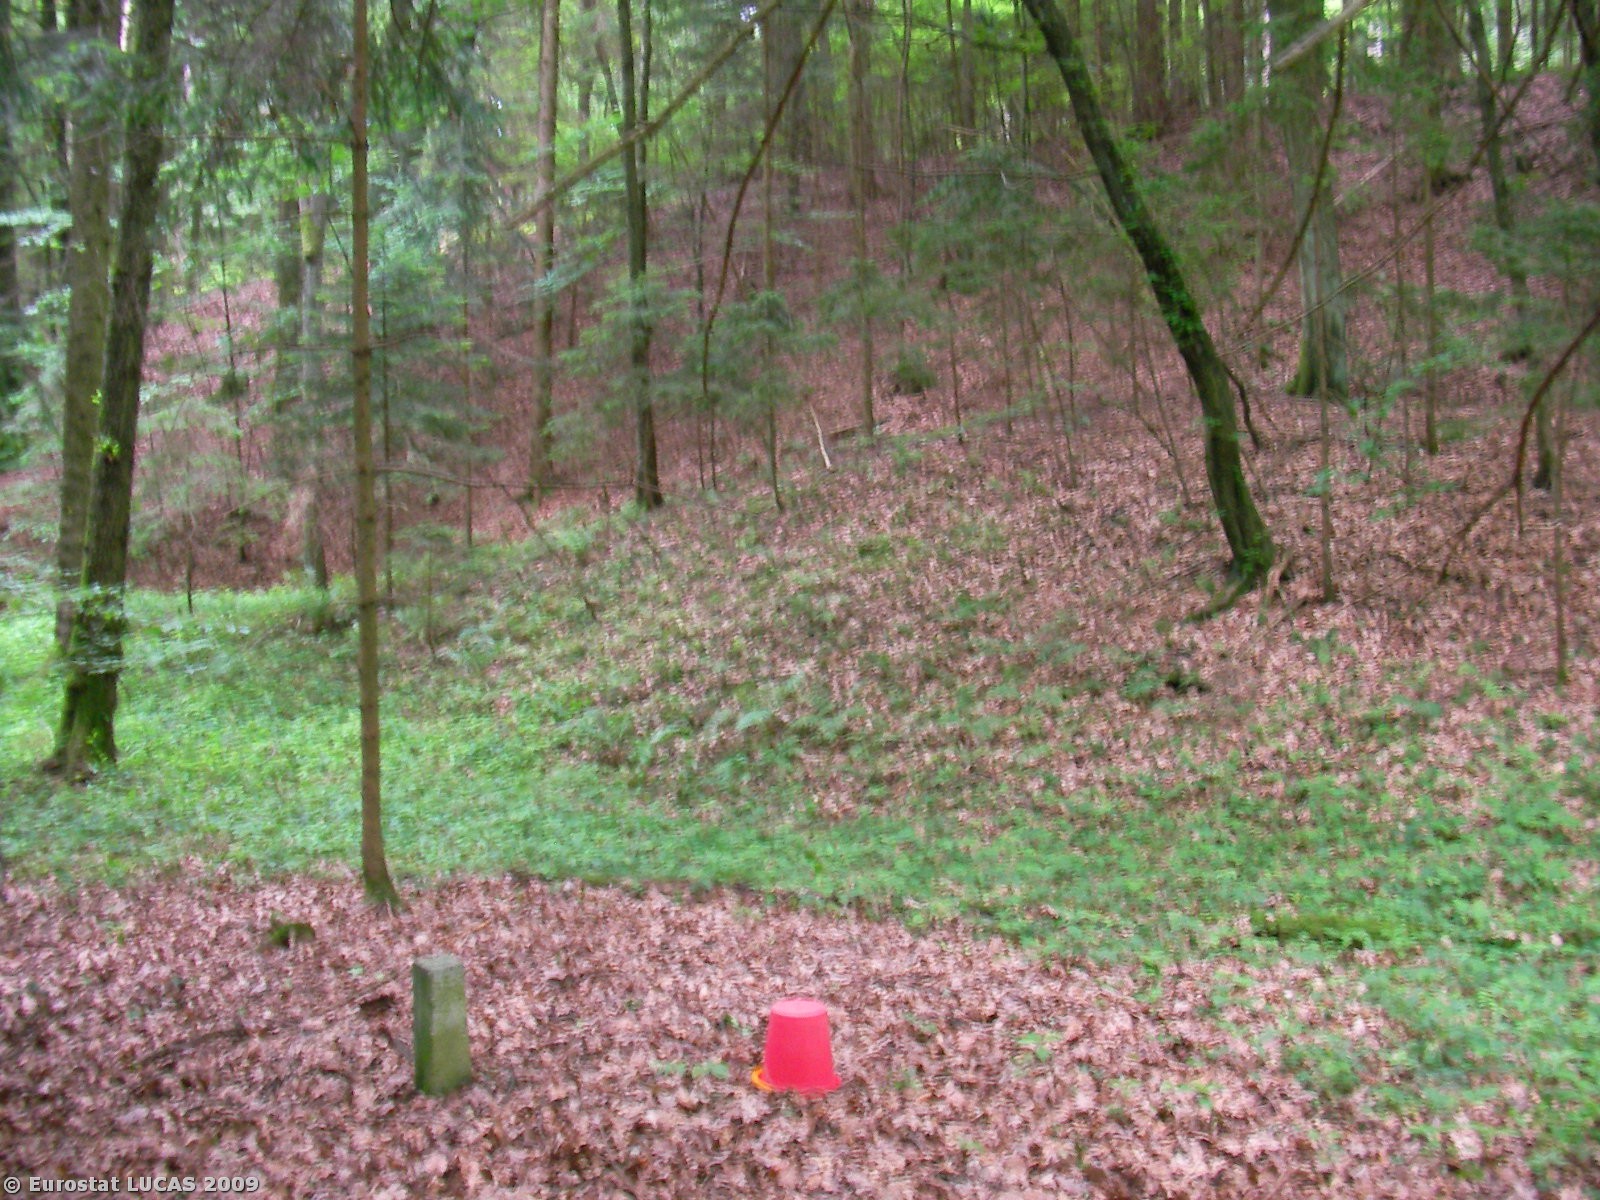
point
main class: Woodland
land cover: Mixed woodland
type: hemiboreal forest and nemoral coniferous forest and mixed broadleaved-coniferous forest
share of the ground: > 75 %
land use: Forestry
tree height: > 5 m
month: June
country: AT
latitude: 47.0642
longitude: 15.7281
